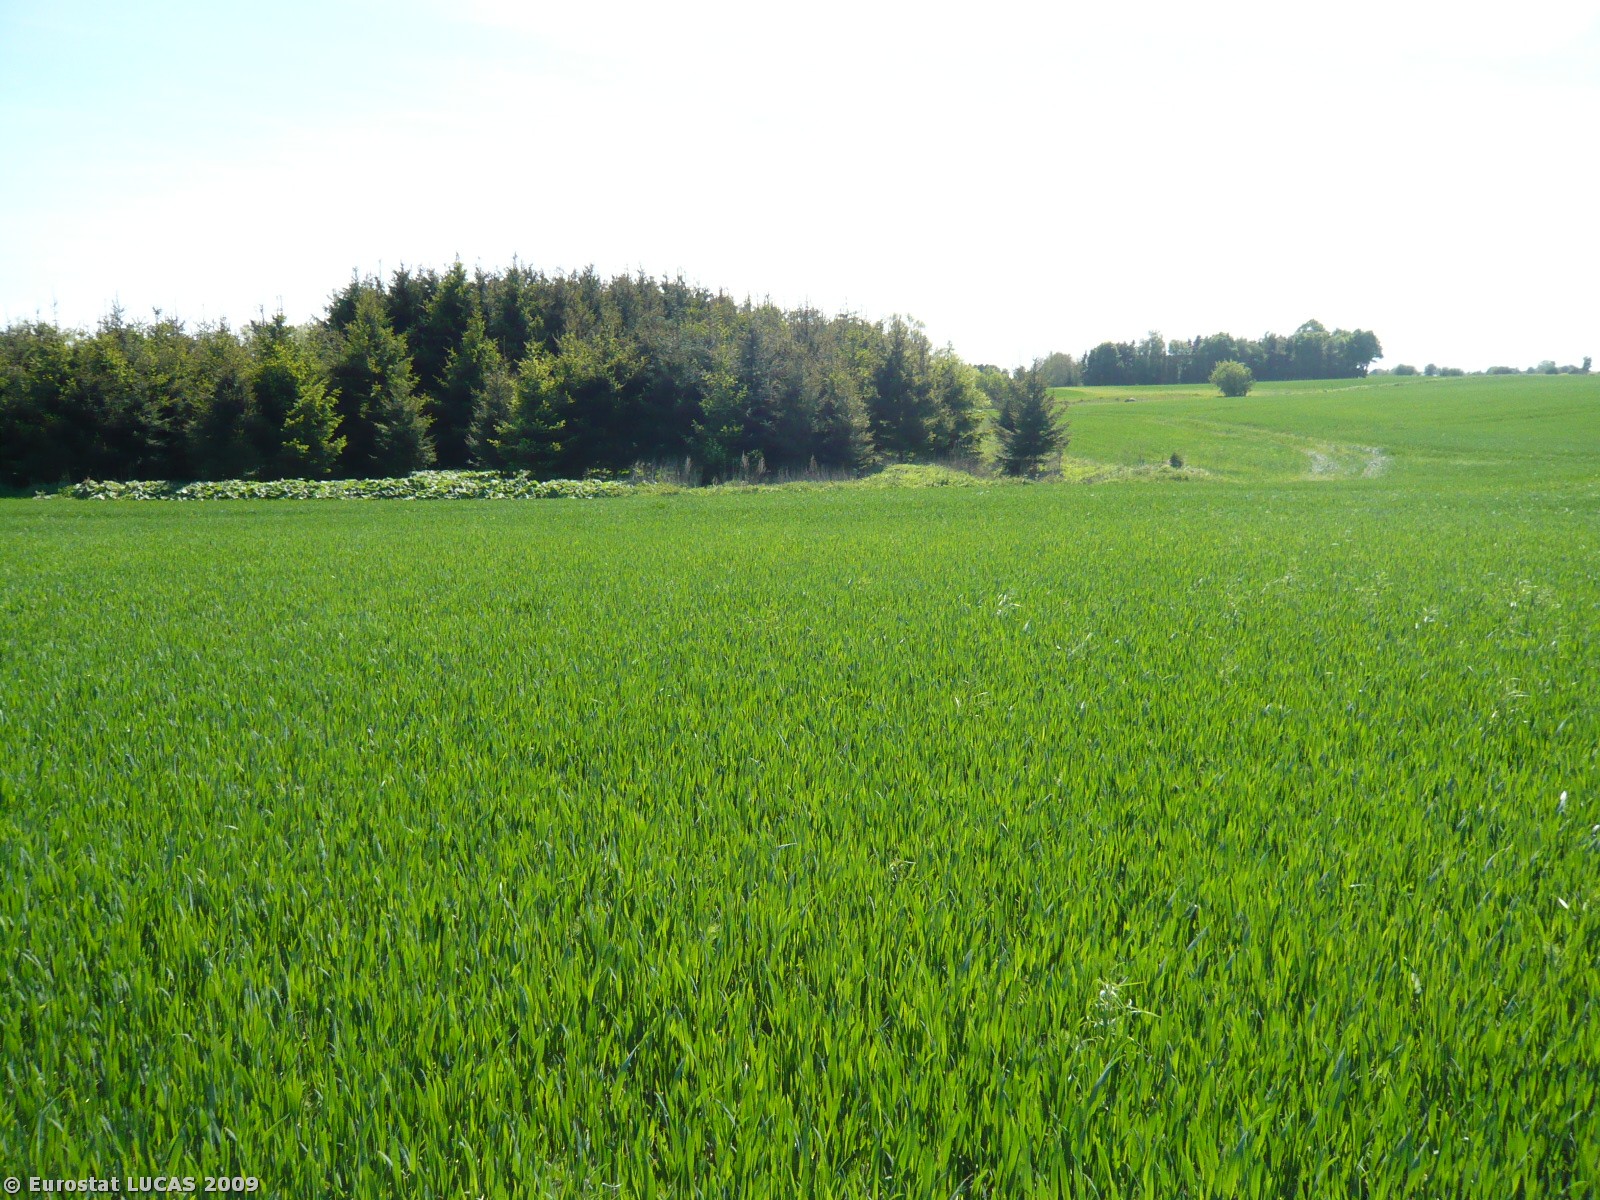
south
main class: Cropland
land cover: Common wheat
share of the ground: > 75 %
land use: Agriculture (excluding fallow land and kitchen gardens)
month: May
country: DK
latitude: 55.2383
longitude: 11.9329
